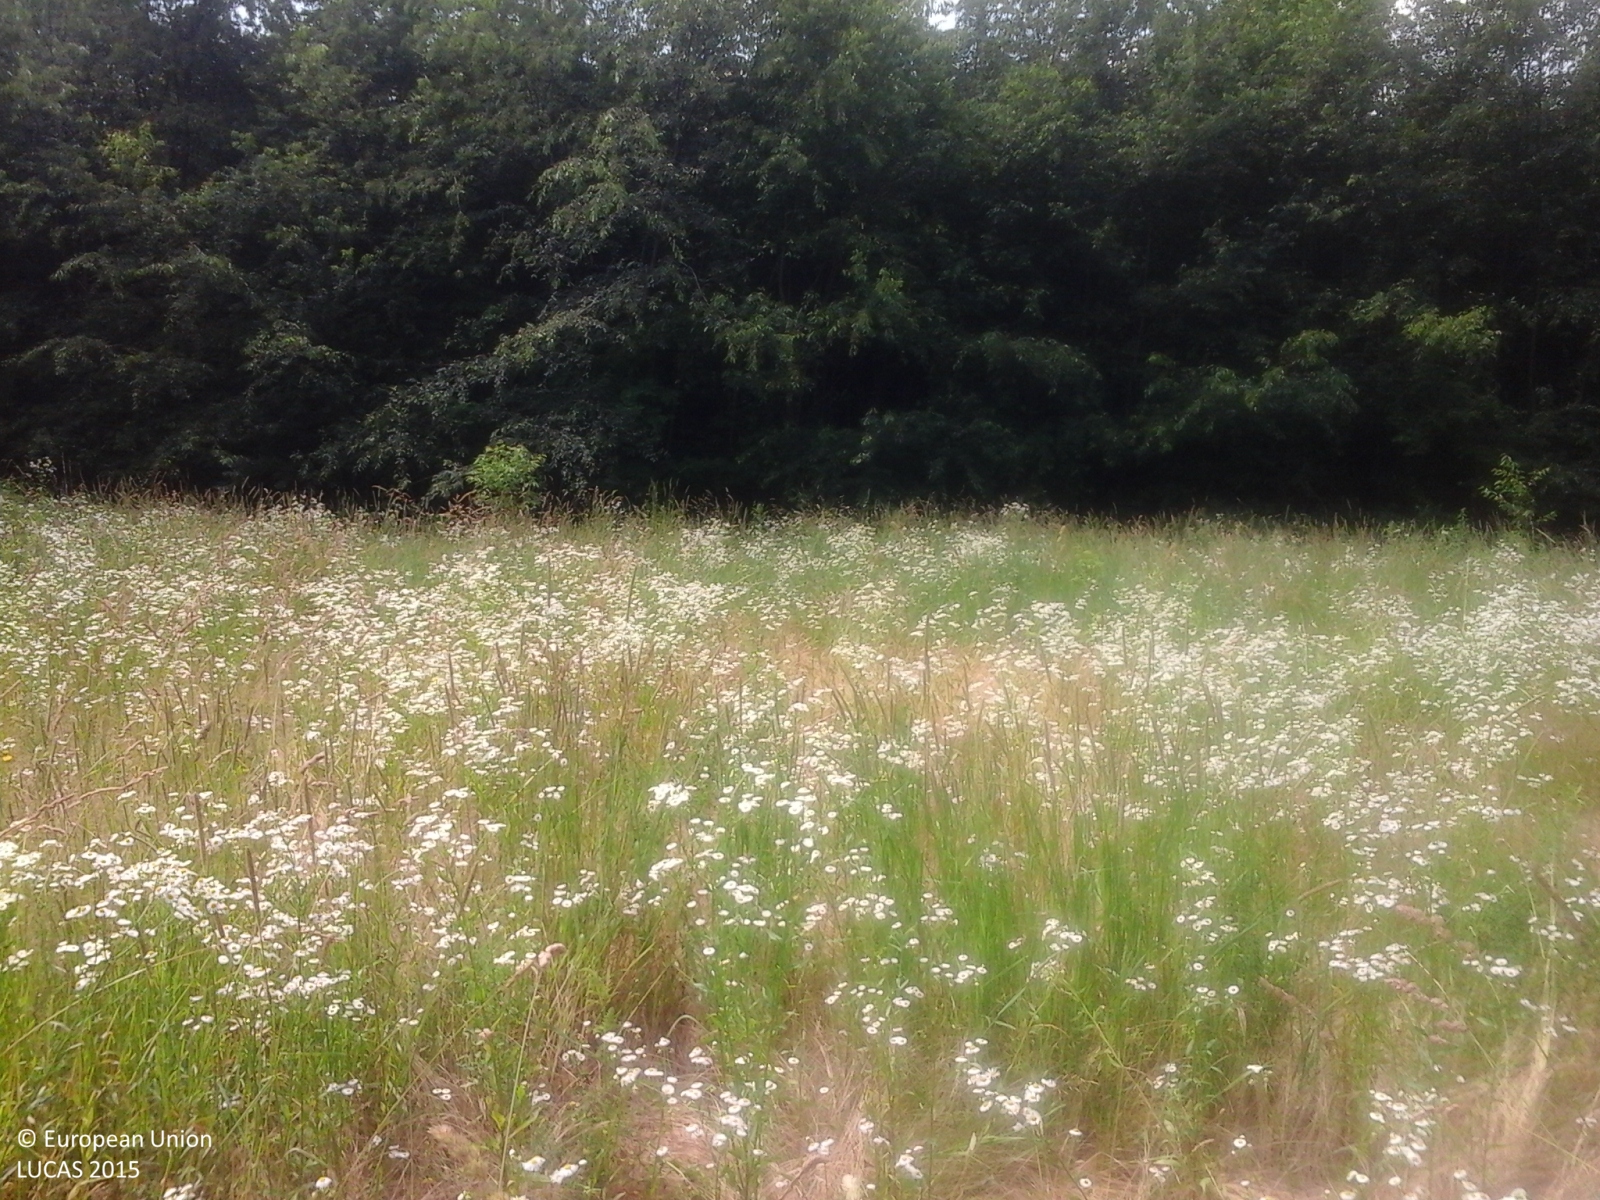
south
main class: Grassland
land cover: Spontaneously vegetated surfaces
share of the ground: > 75 %
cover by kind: herbaceous plants 100 %
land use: Fallow land
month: June
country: IT
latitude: 45.5698
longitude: 8.8103
